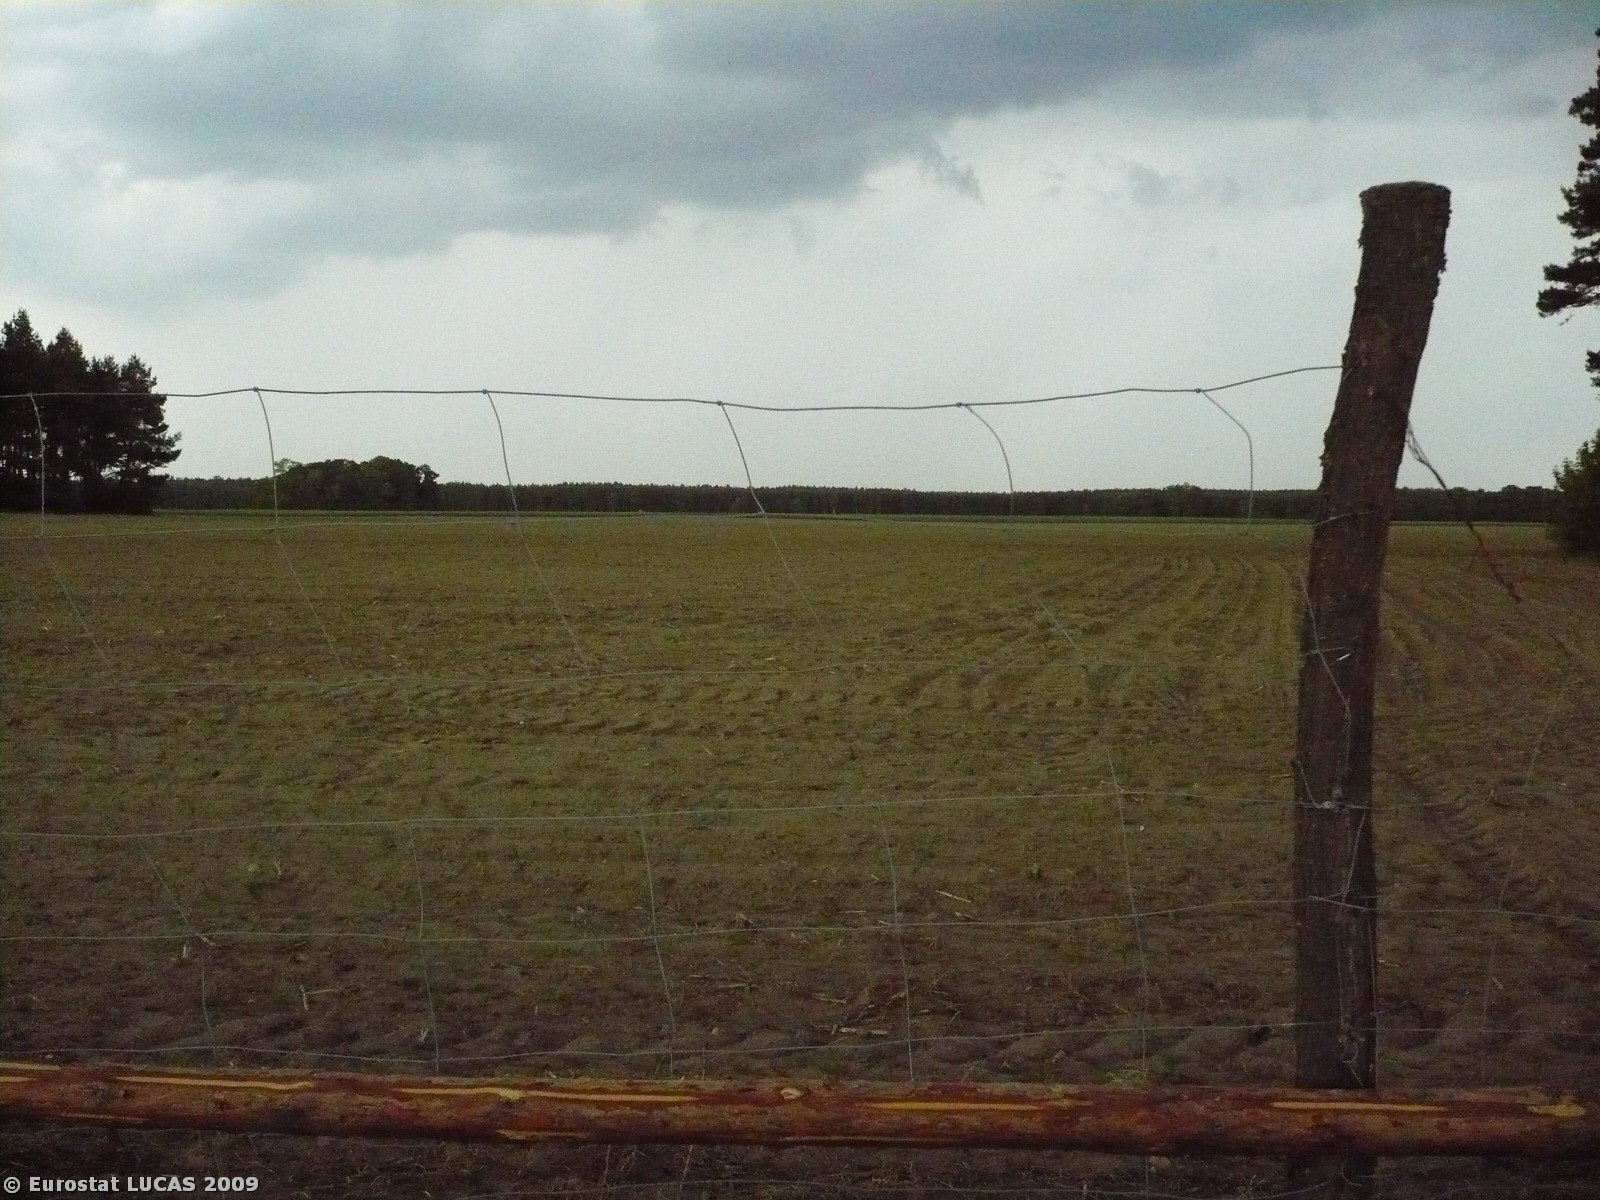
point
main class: Cropland
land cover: Maize
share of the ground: < 10 %
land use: Agriculture (excluding fallow land and kitchen gardens)
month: May
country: PL
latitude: 52.1315
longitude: 15.3358
